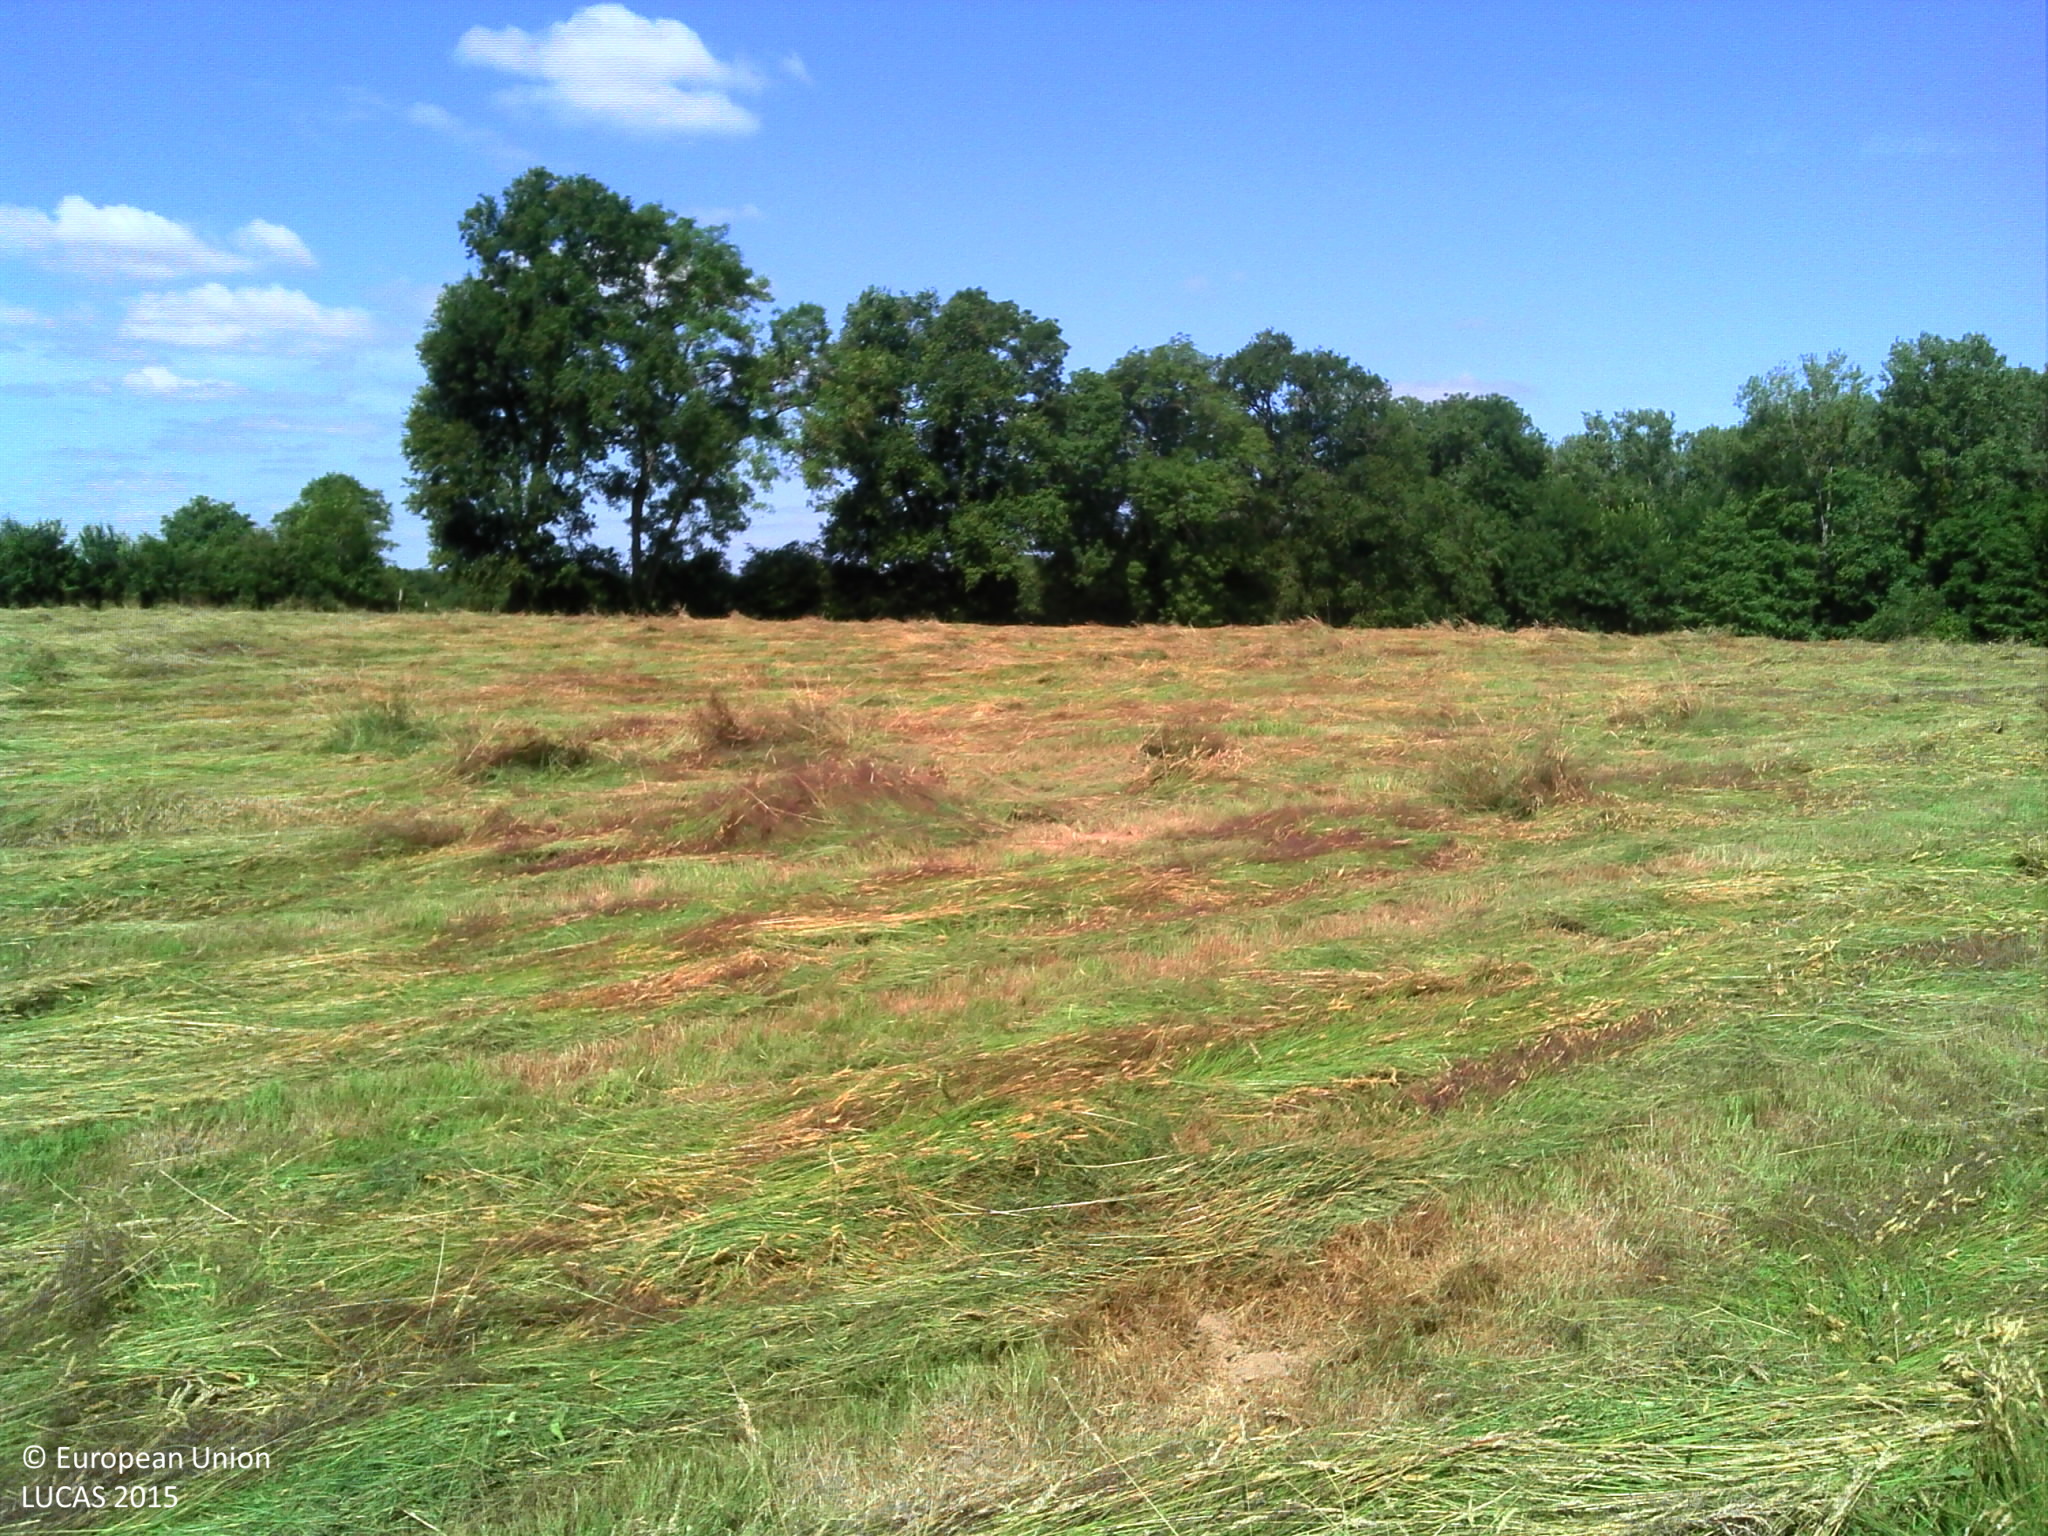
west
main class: Grassland
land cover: Grassland without tree/shrub cover
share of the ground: > 75 %
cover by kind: herbaceous plants 100 %
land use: Agriculture (excluding fallow land and kitchen gardens)
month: June
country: FR
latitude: 47.2684
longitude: 2.5781
